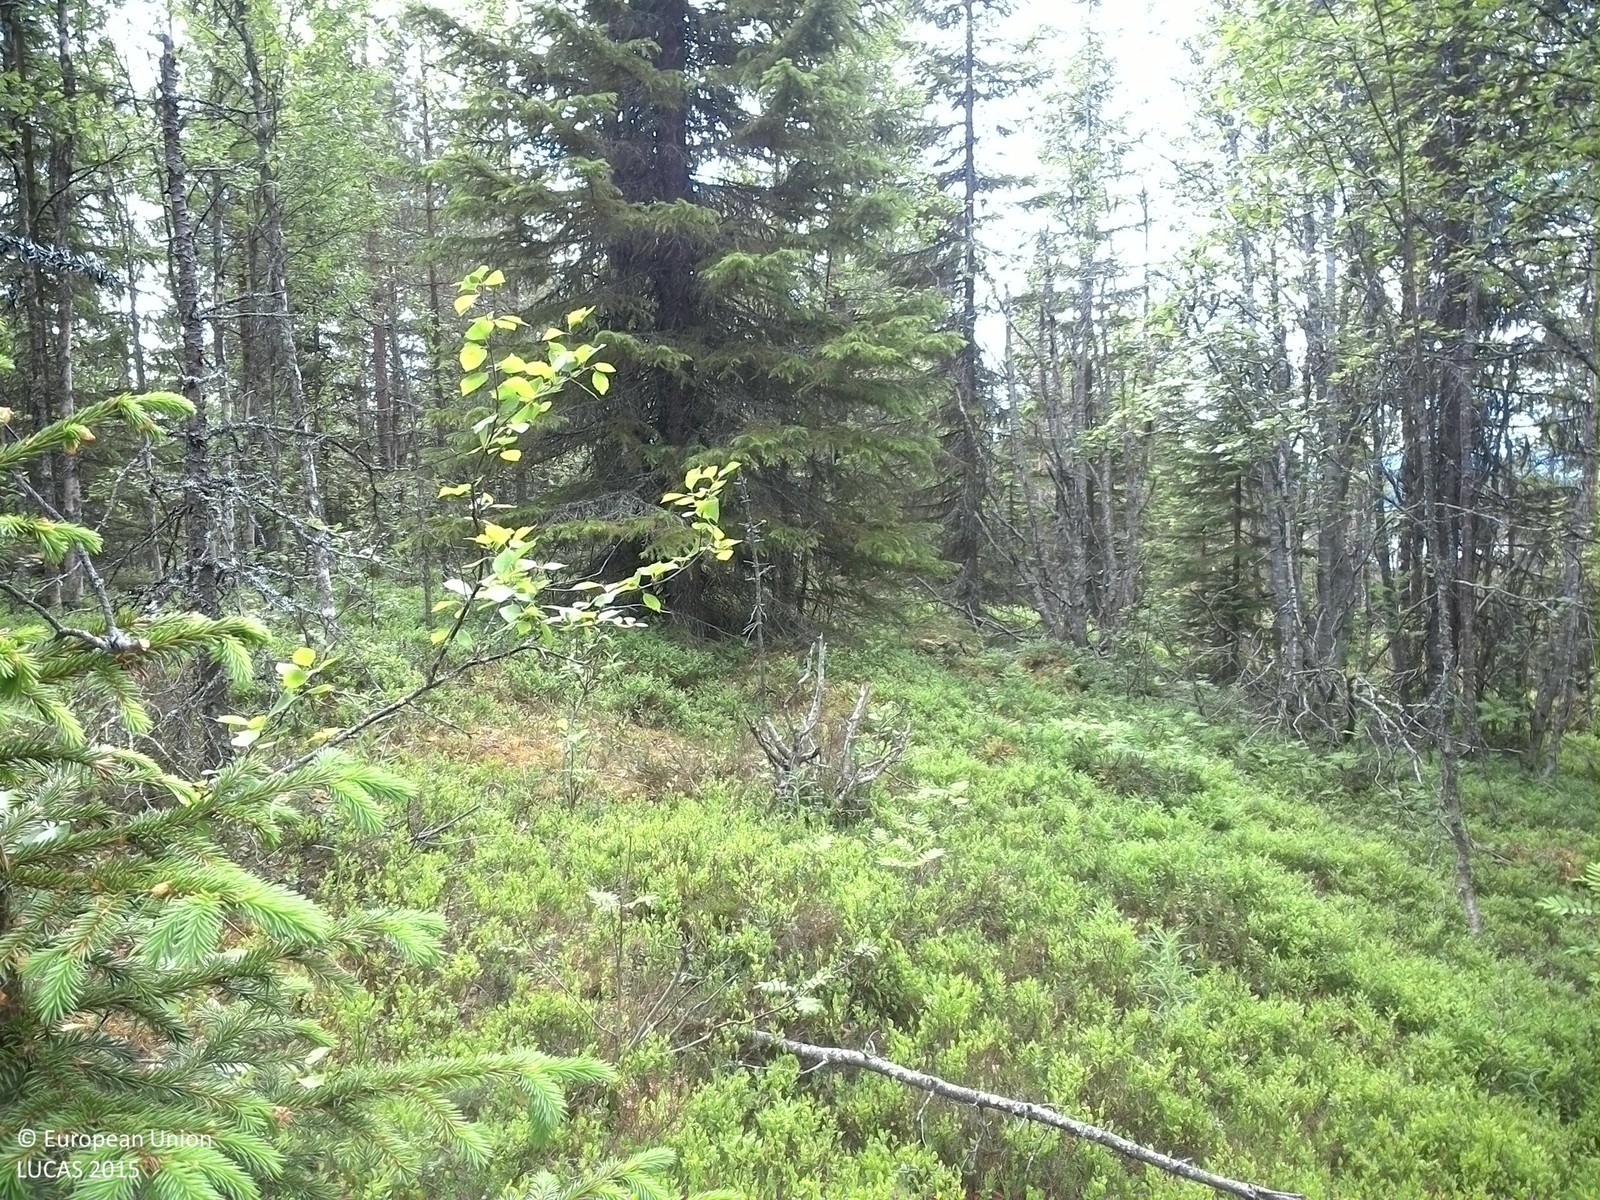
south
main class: Woodland
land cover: Spruce dominated mixed woodland
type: boreal forest
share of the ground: 50 - 75 %
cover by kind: coniferous forest trees 45 %, shrubs 30 %, broadleaved forest trees 15 %, lichens and mosses 10 %
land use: Forestry
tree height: > 5 m
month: July
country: SE
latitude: 64.1251
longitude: 16.8089
